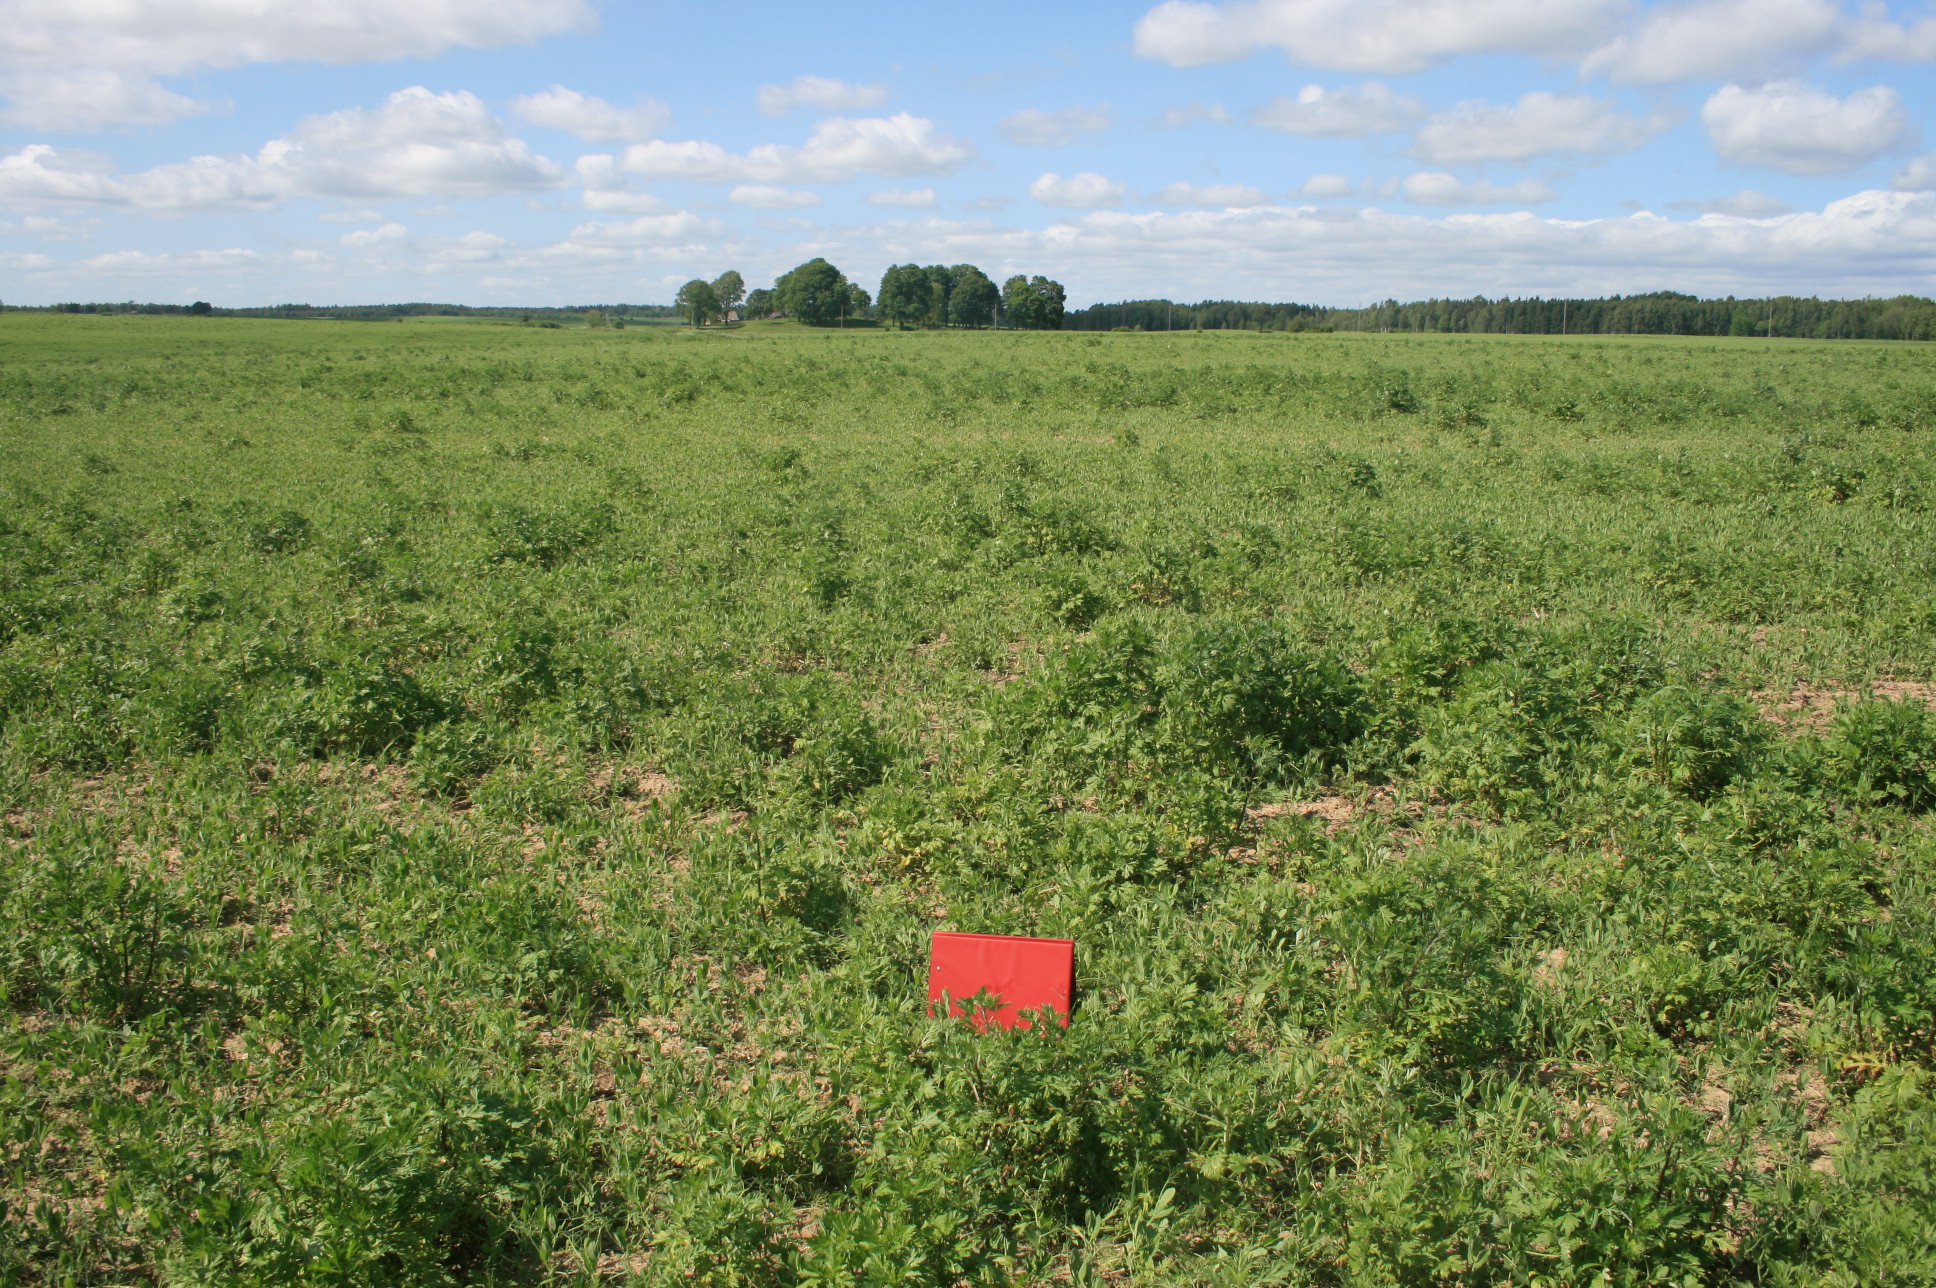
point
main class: Cropland
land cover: Dry pulses
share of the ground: > 75 %
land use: Agriculture (excluding fallow land and kitchen gardens)
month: June
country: LT
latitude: 56.0595
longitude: 22.3746
